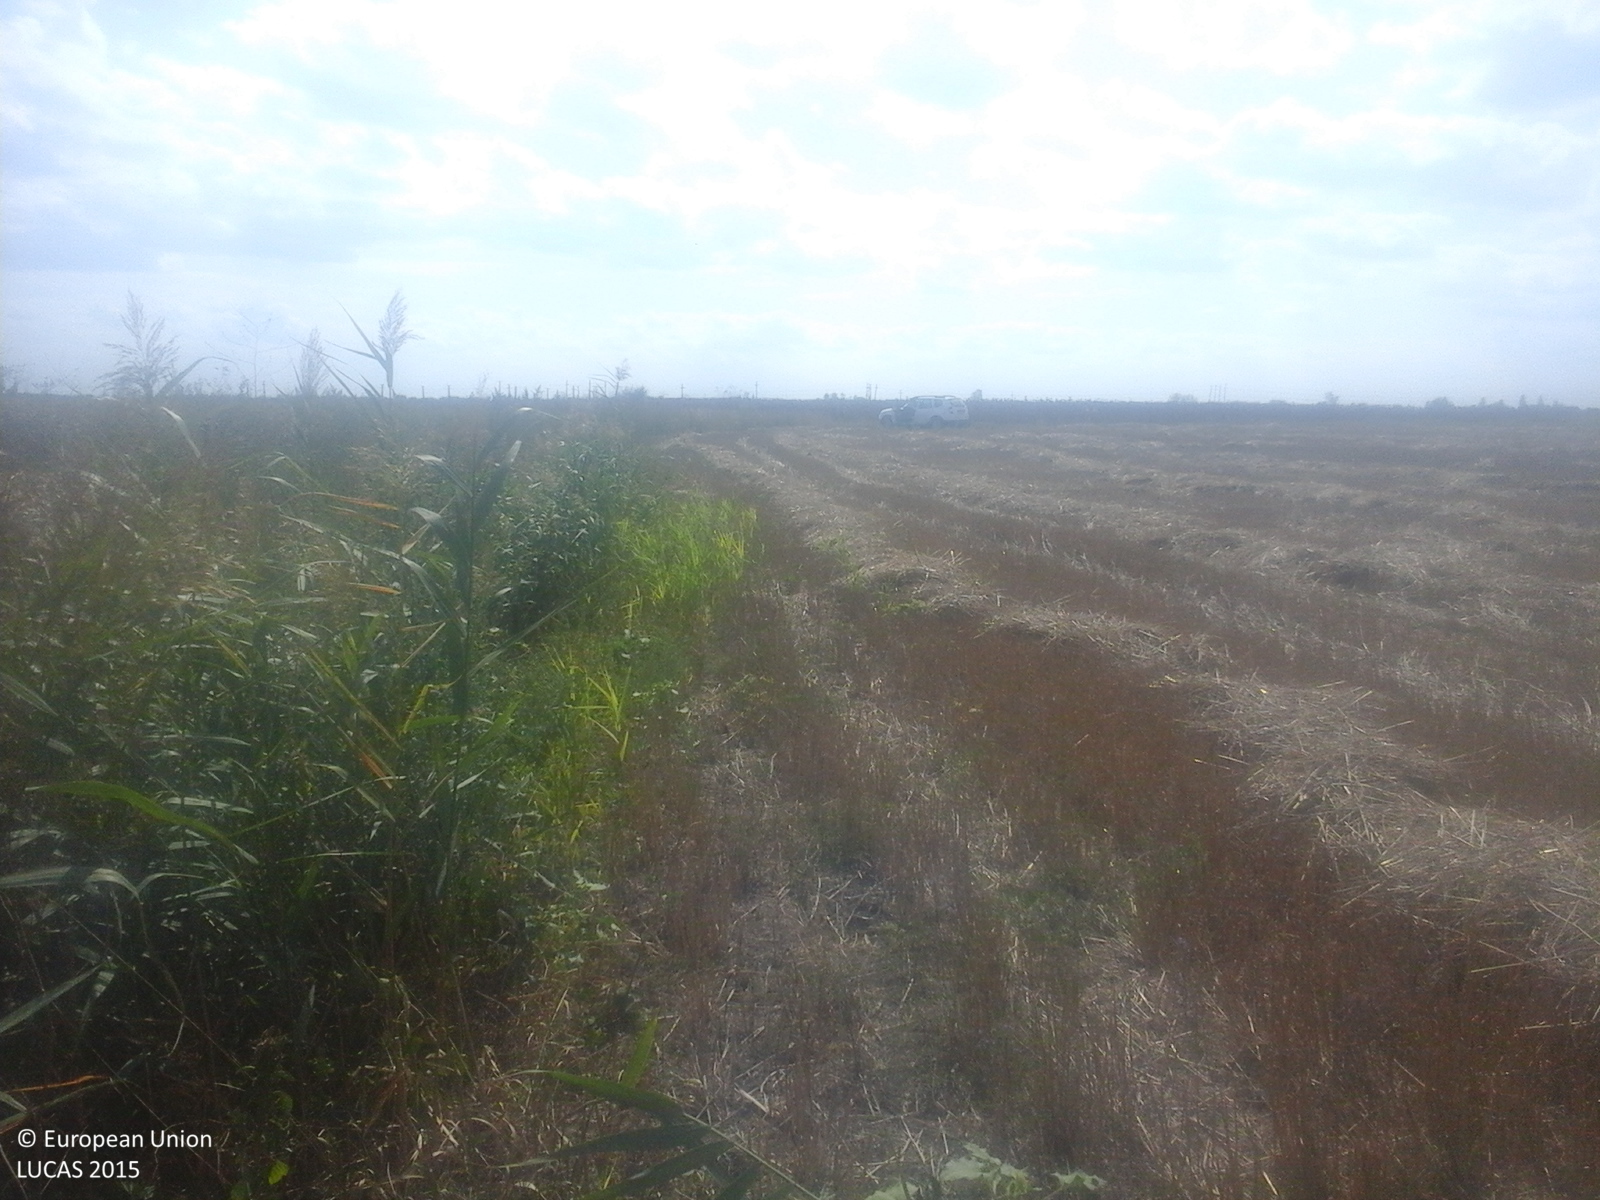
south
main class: Cropland
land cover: Sunflower
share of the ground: > 75 %
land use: Agriculture (excluding fallow land and kitchen gardens)
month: September
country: RO
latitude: 47.7092
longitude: 22.6556
